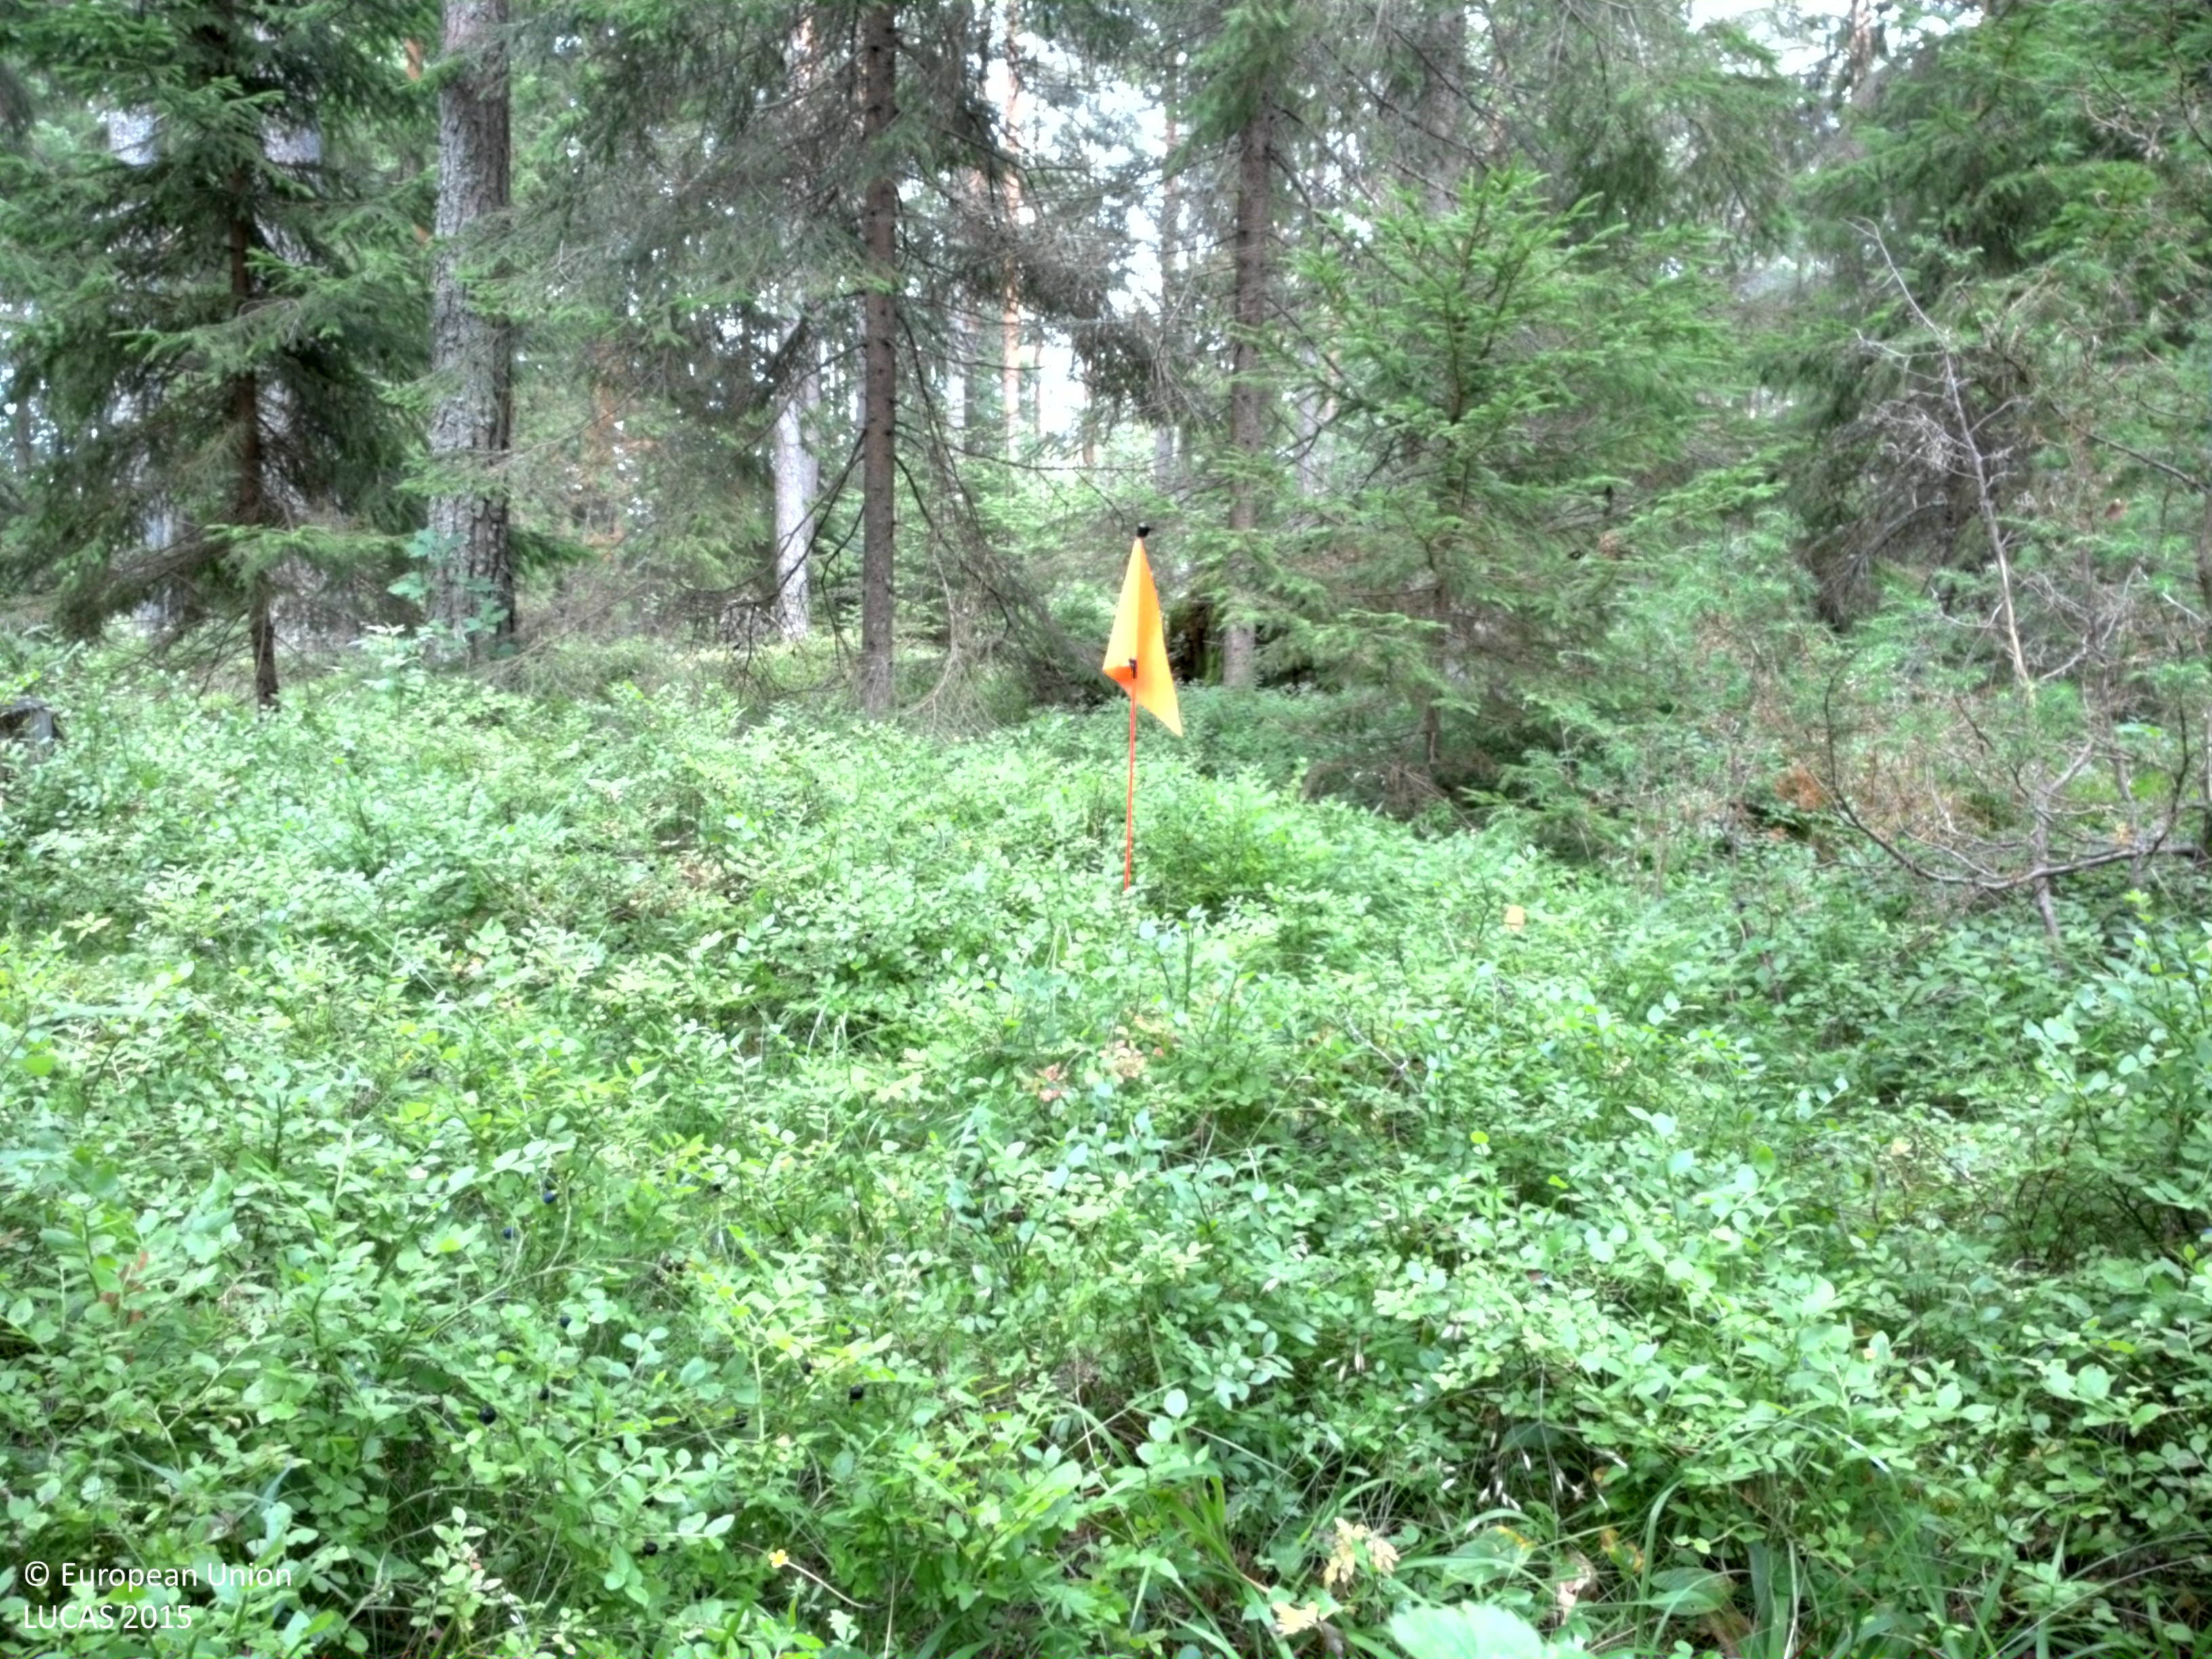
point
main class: Woodland
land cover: Spruce dominated coniferous woodland
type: boreal forest
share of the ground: 50 - 75 %
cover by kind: coniferous forest trees 70 %, shrubs 10 %, lichens and mosses 10 %, broadleaved forest trees 5 %, herbaceous plants 5 %
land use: Forestry
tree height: > 5 m
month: July
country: SE
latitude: 59.5187
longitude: 18.6079
